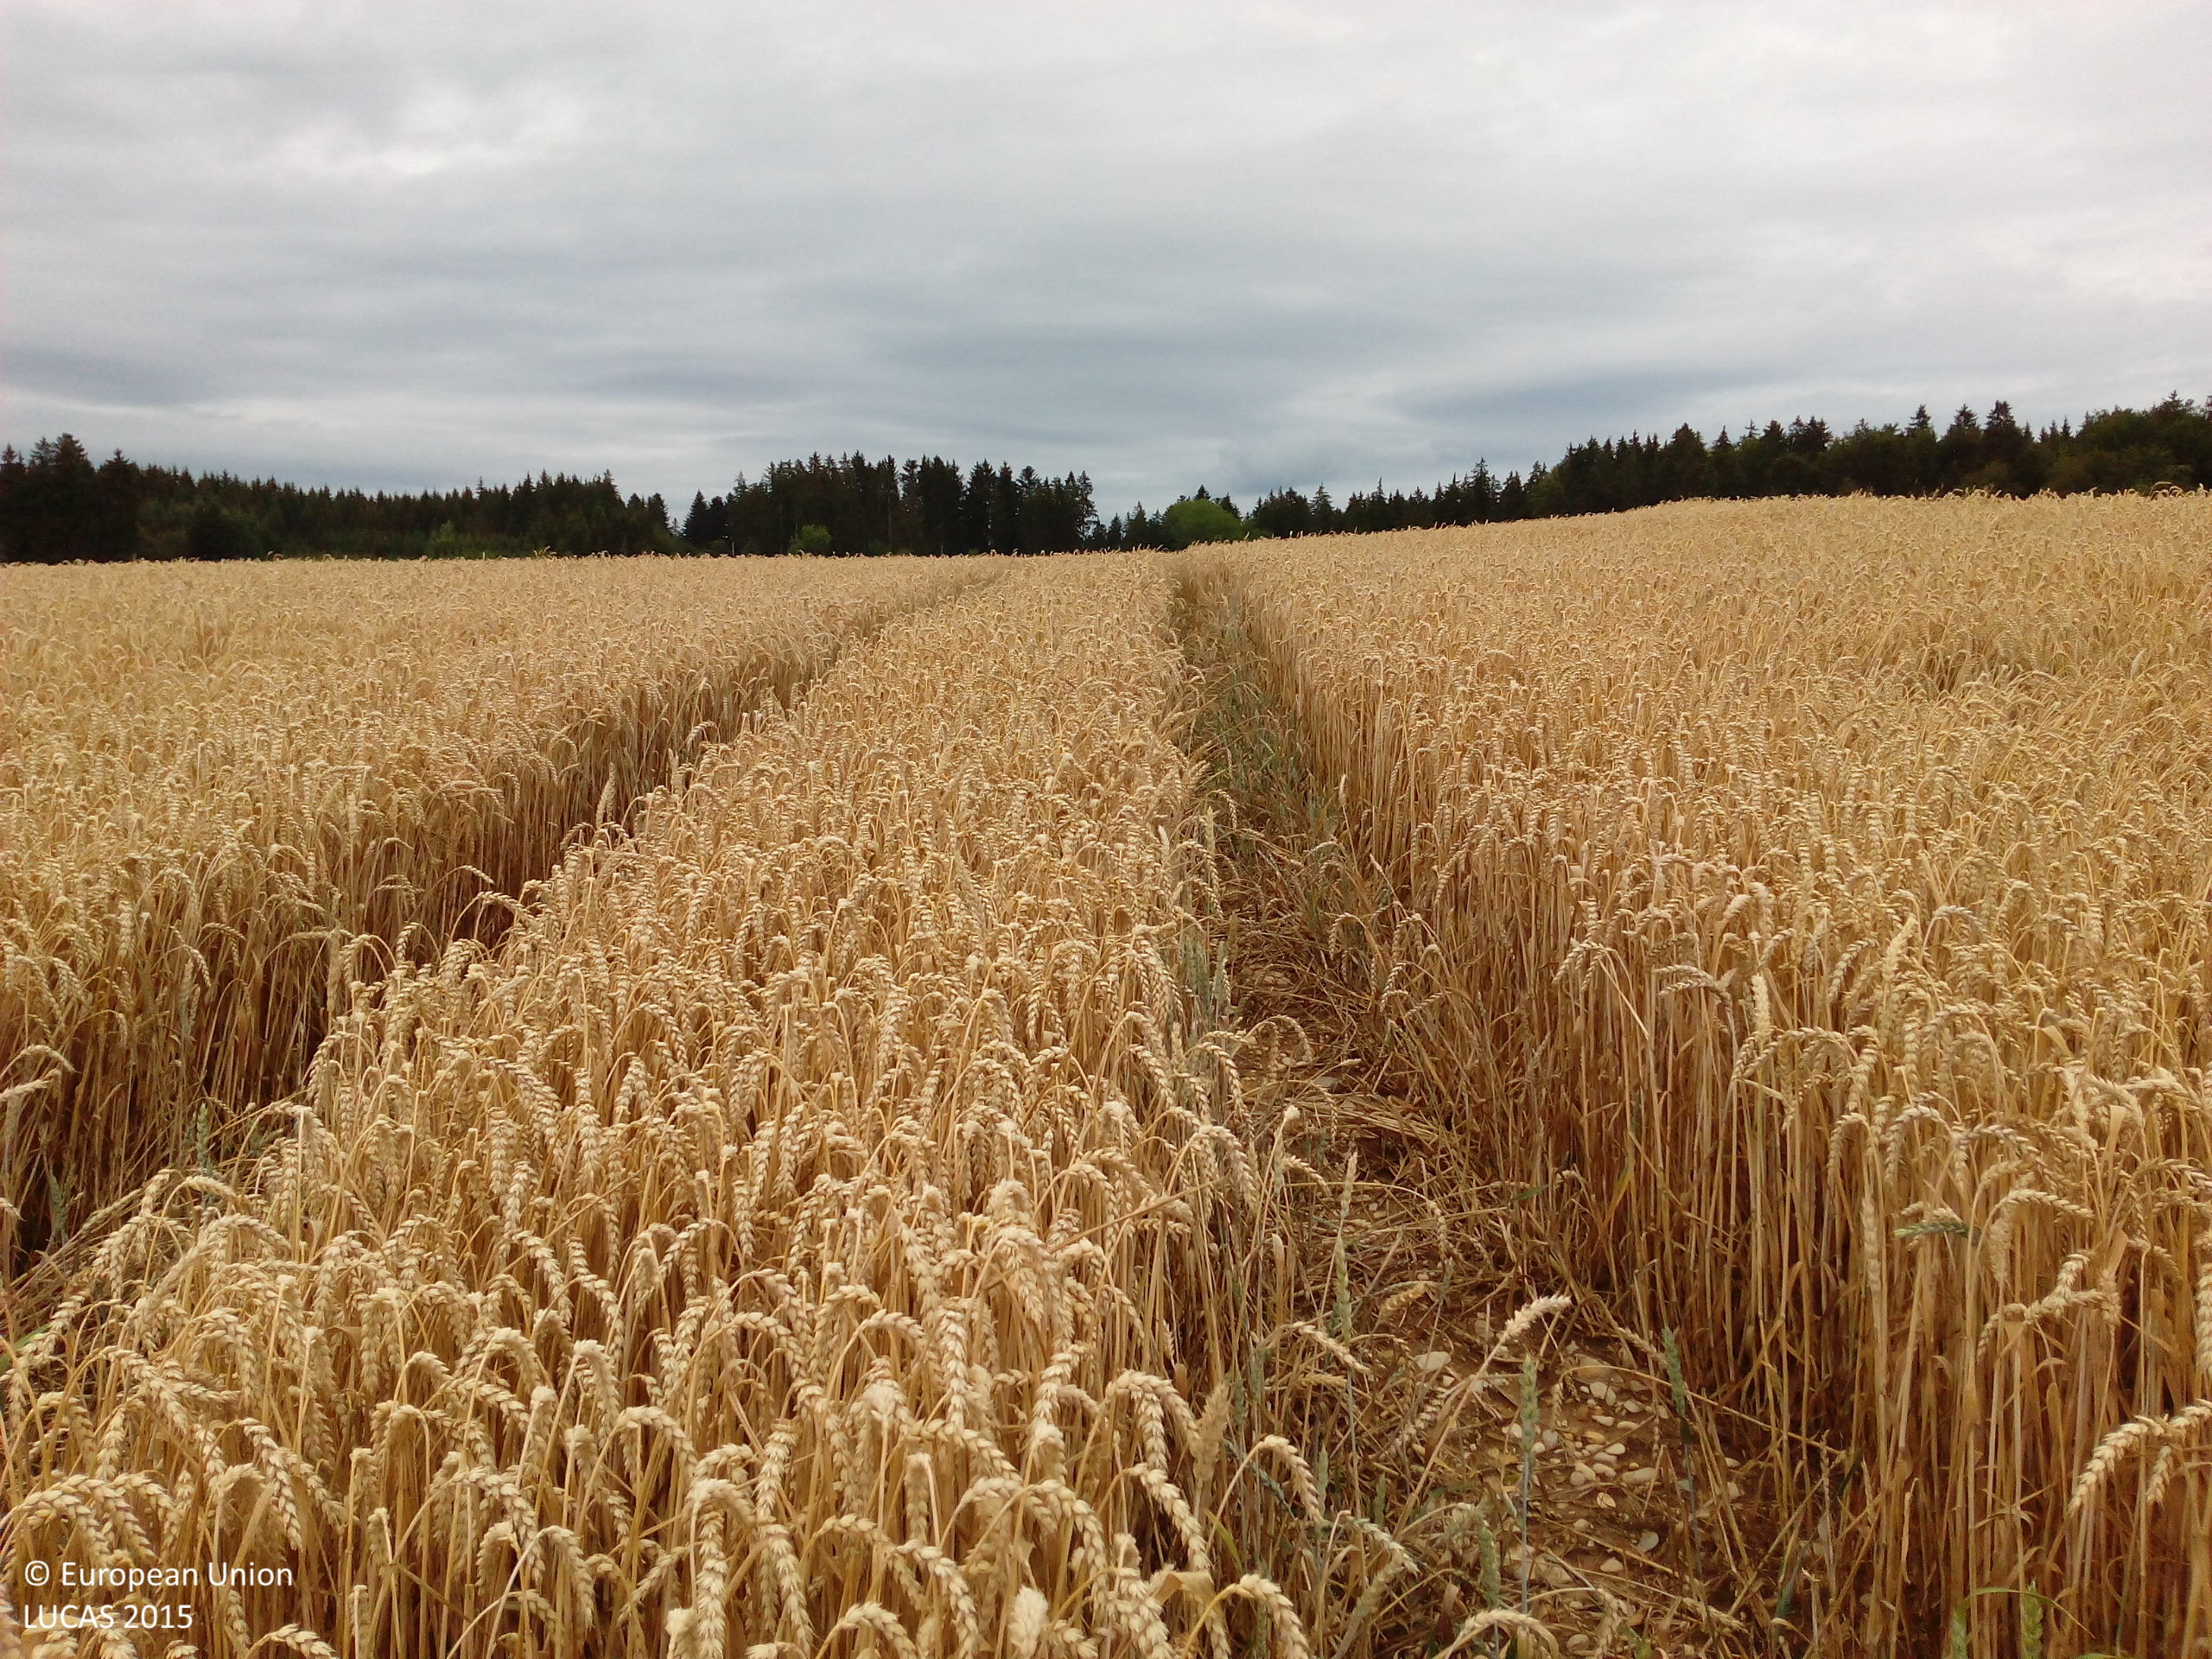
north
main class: Artificial land
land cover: Other artificial areas
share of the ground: 25 - 50 %
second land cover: Common wheat
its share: > 75 %
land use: Electricity, gas and thermal power distribution
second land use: Agriculture (excluding fallow land and kitchen gardens)
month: July
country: DE
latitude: 47.8186
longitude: 8.5986
